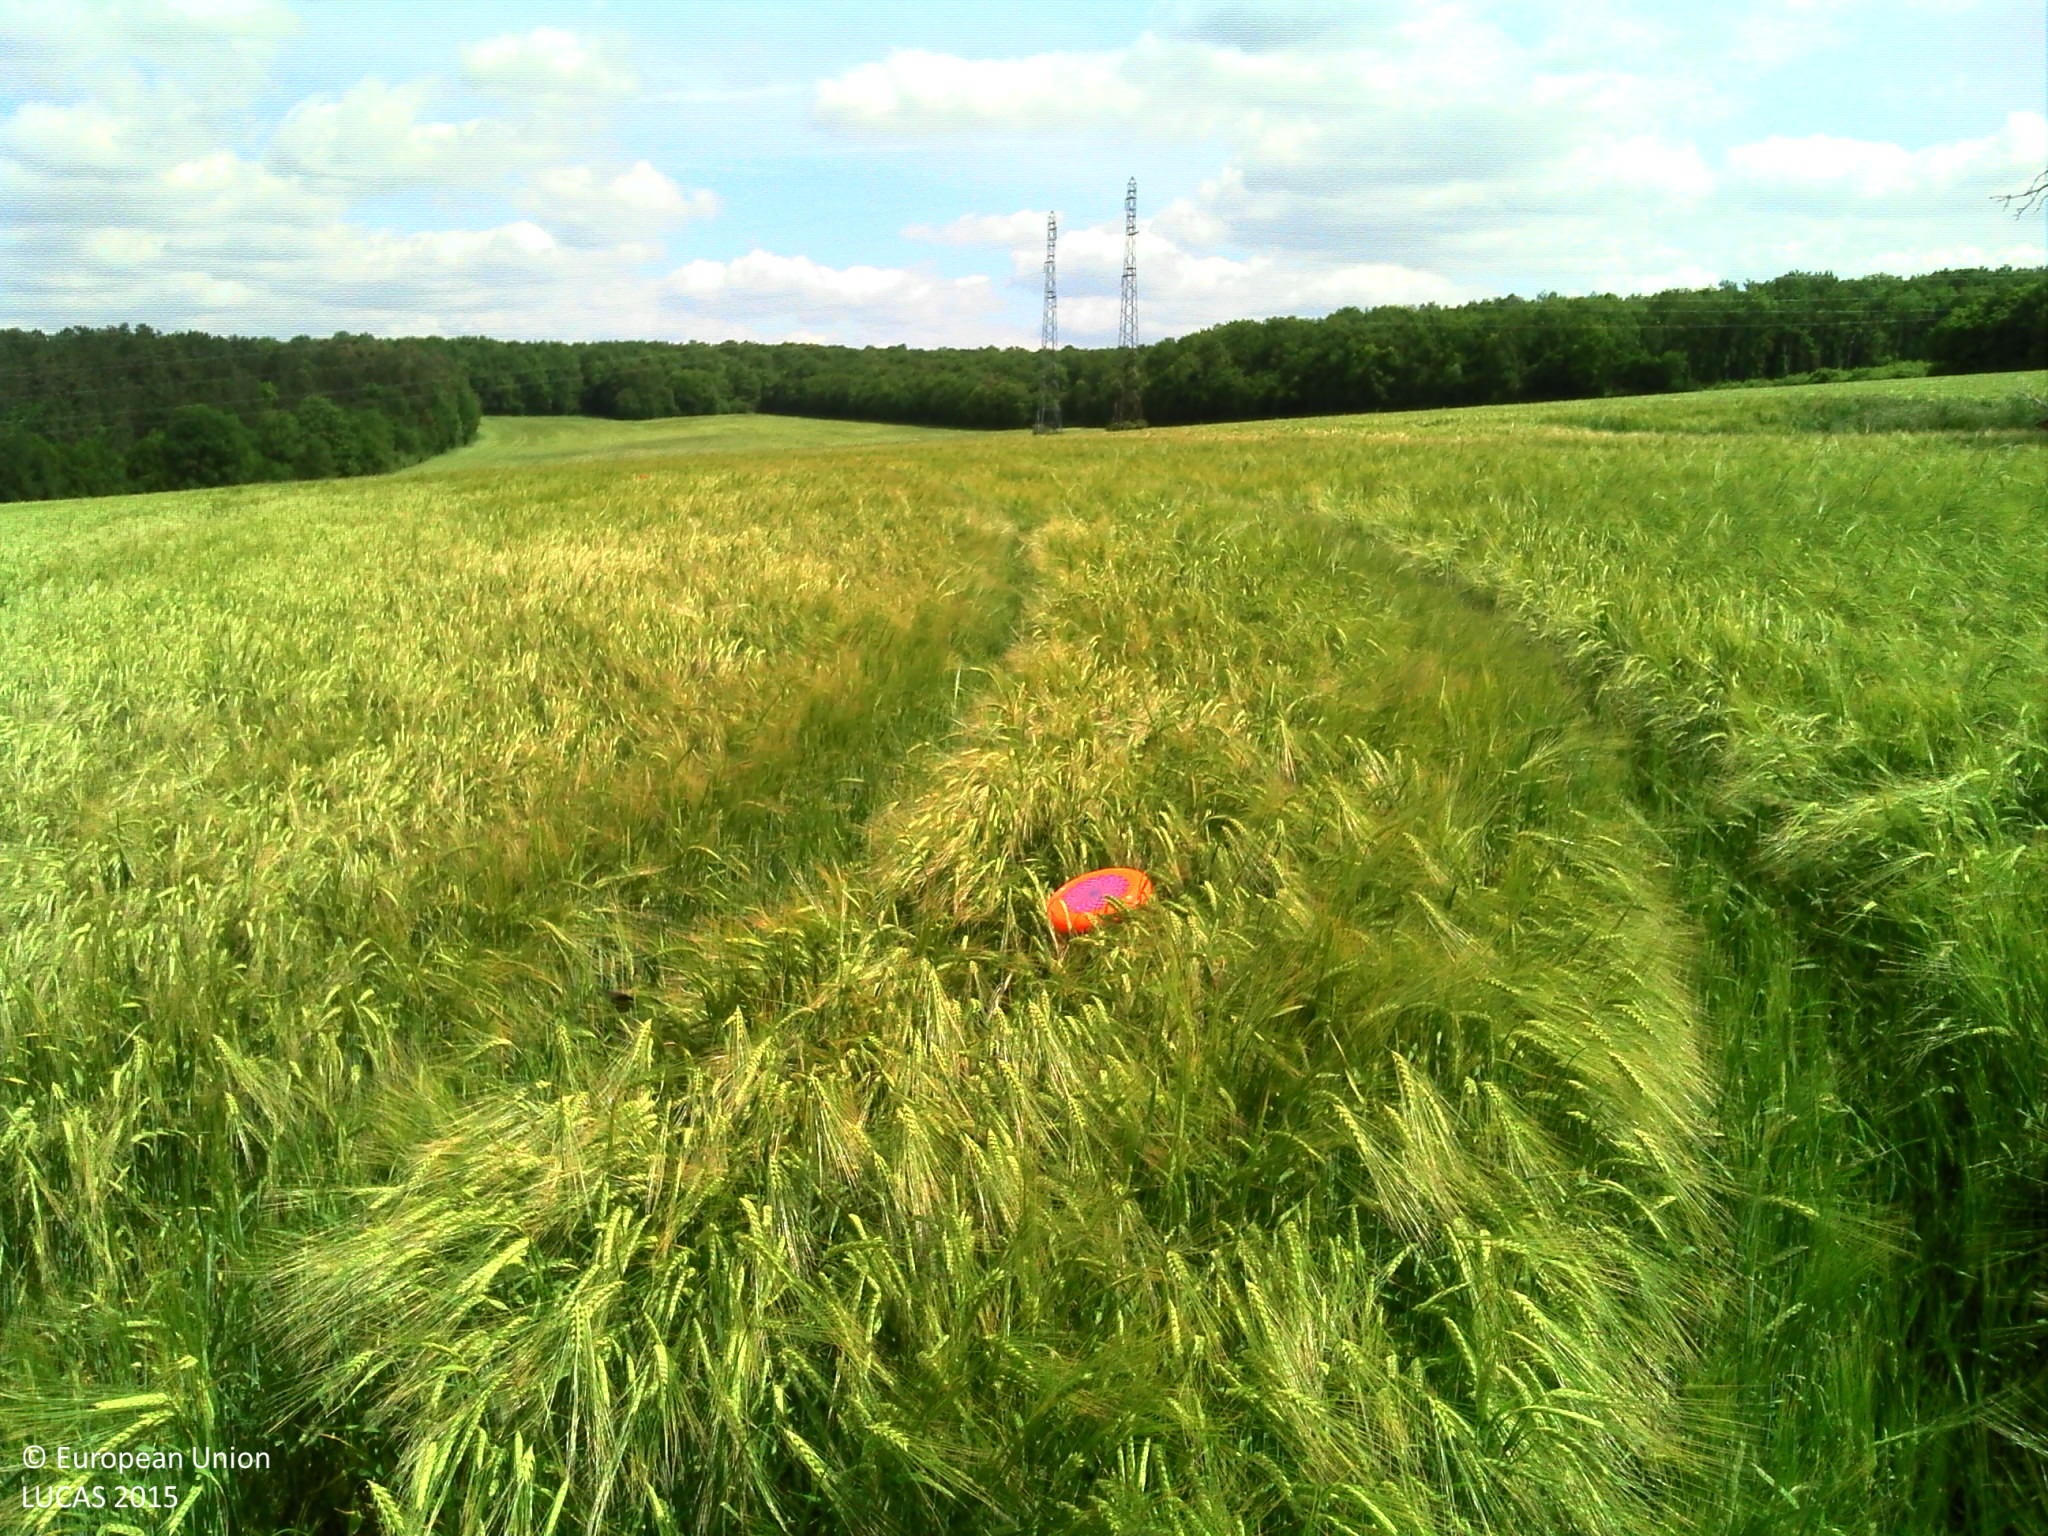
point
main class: Cropland
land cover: Barley
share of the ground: > 75 %
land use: Agriculture (excluding fallow land and kitchen gardens)
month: May
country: FR
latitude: 47.3304
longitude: 4.9056
